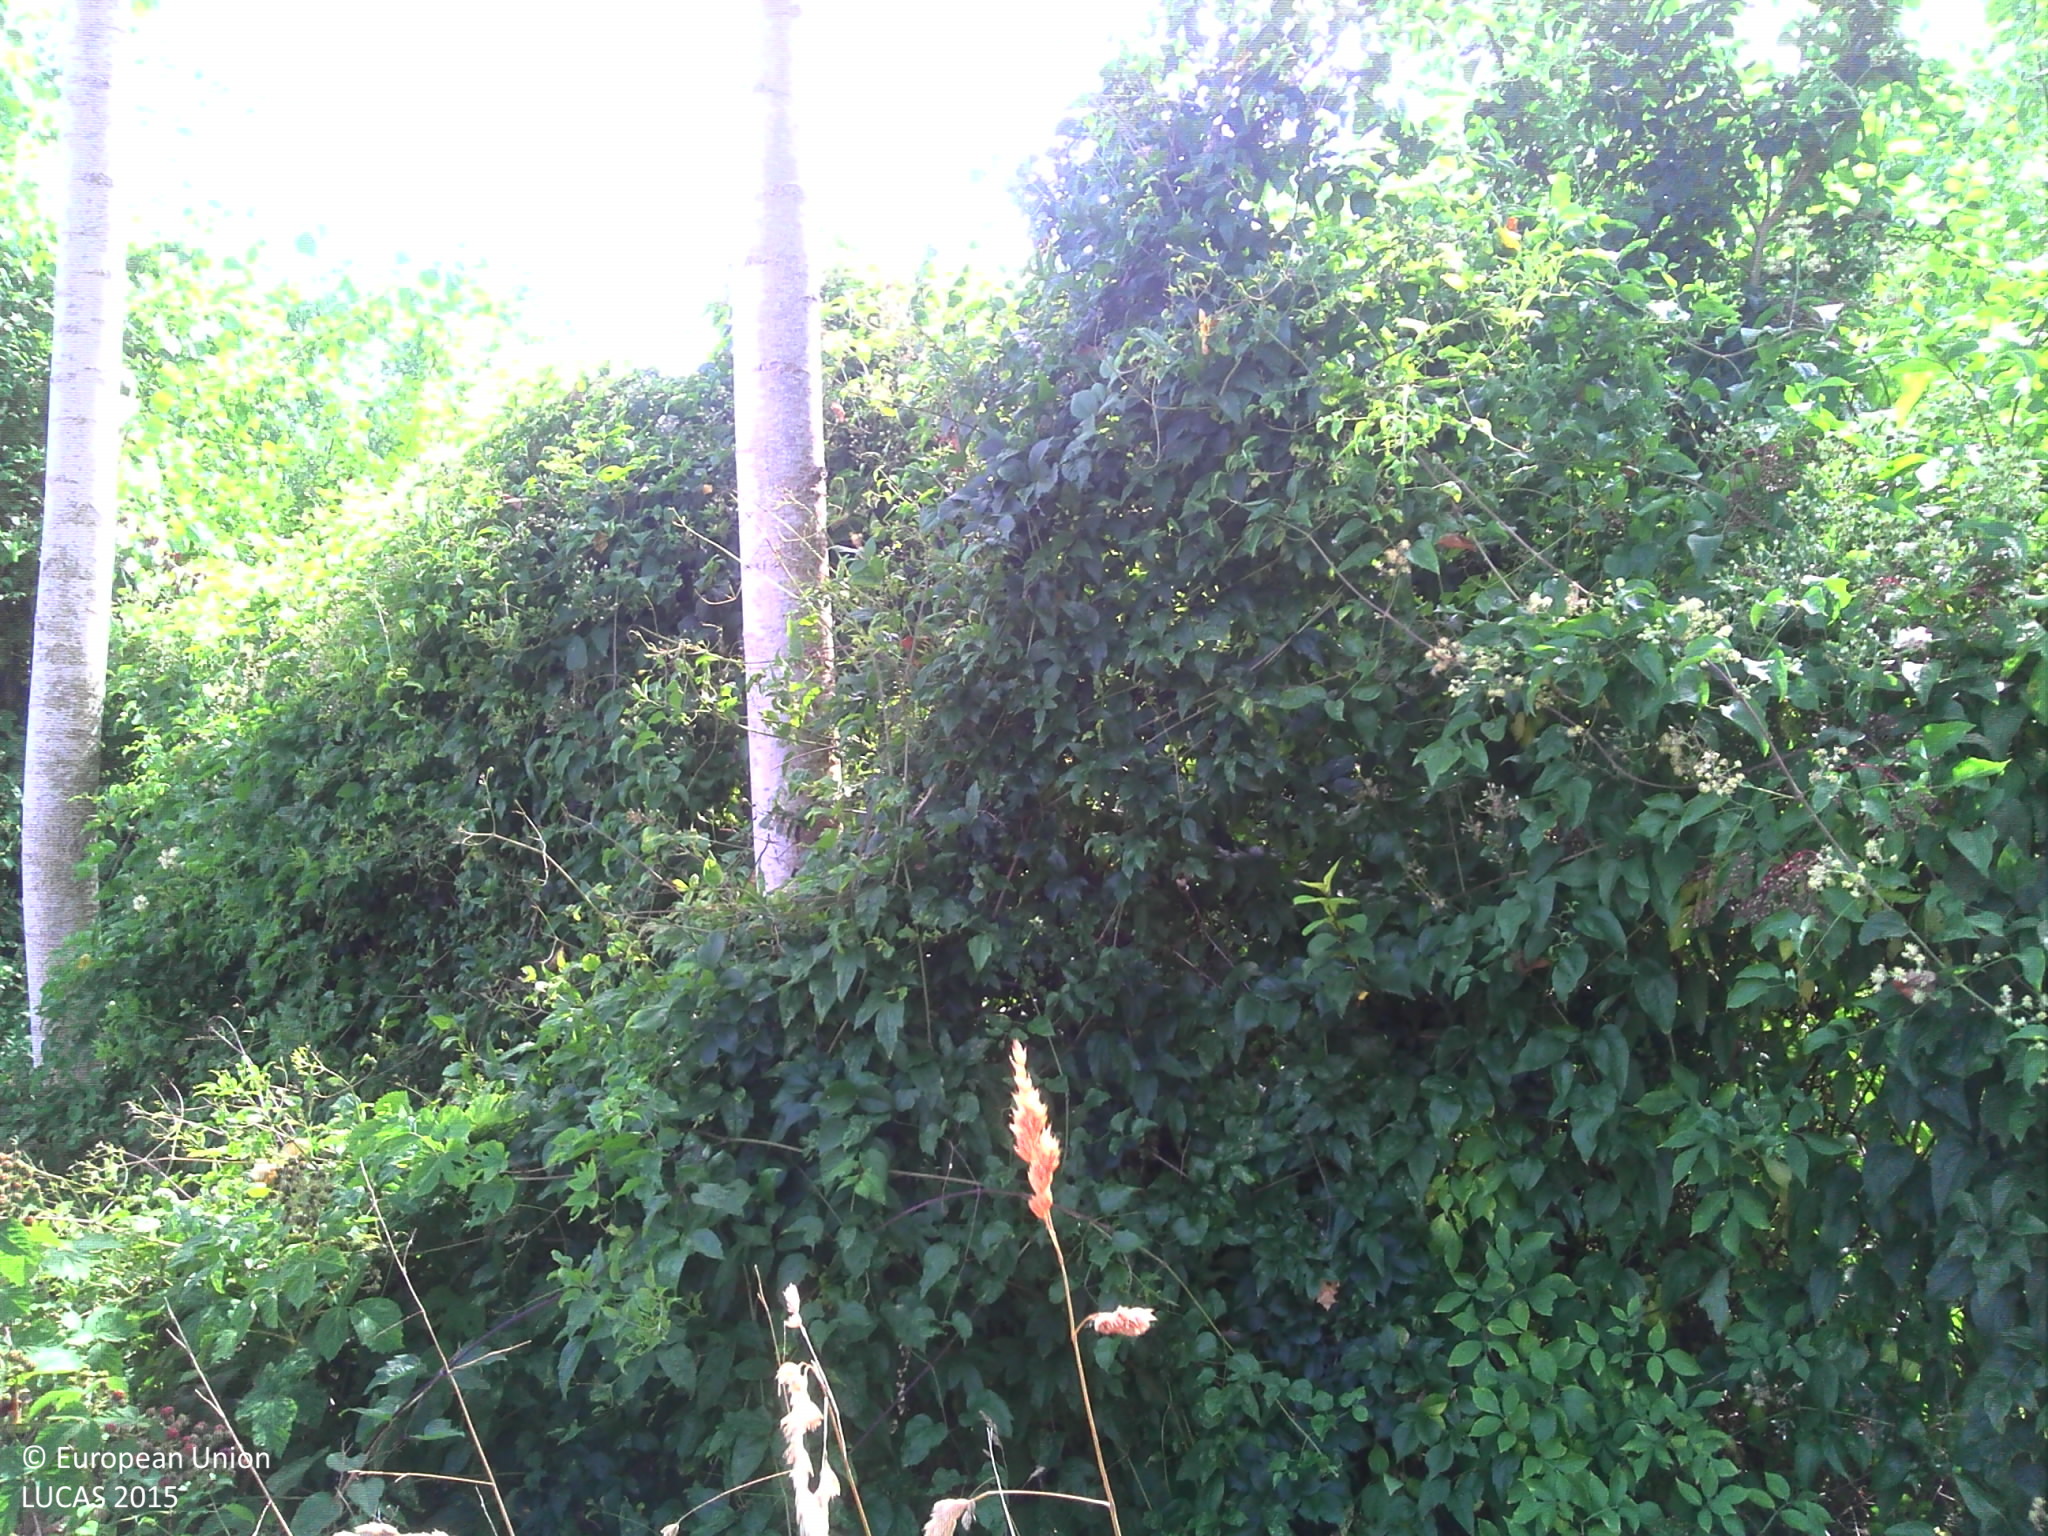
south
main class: Woodland
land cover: Broadleaved woodland
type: exotic forest
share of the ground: > 75 %
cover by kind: broadleaved forest trees 55 %, herbaceous plants 15 %, lichens and mosses 15 %, unconsolidated bare surface 5 %
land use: Forestry
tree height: > 5 m
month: August
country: FR
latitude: 48.6890
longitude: 3.3231
